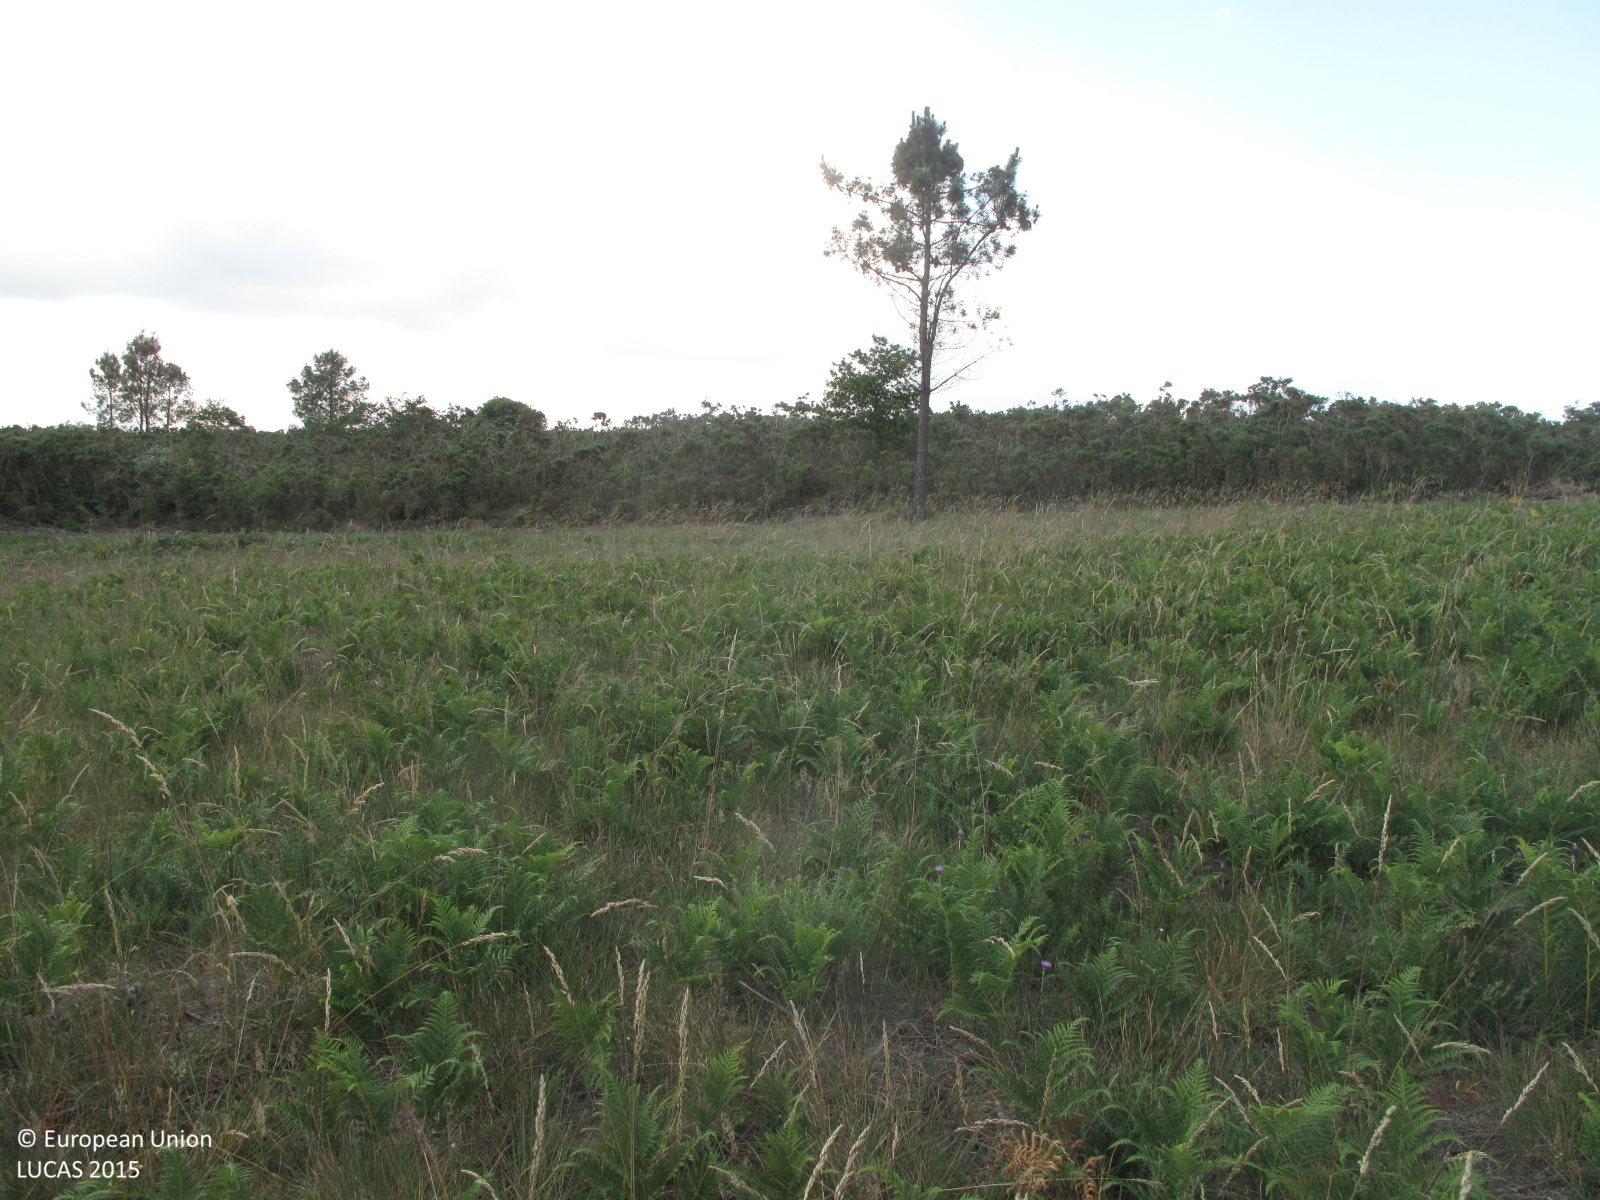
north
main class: Shrubland
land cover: Shrubland without tree cover
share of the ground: 10 - 25 %
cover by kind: herbaceous plants 90 %, shrubs 10 %
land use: Abandoned areas
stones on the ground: < 10 %
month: June
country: ES
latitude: 42.9023
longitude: -8.5371
